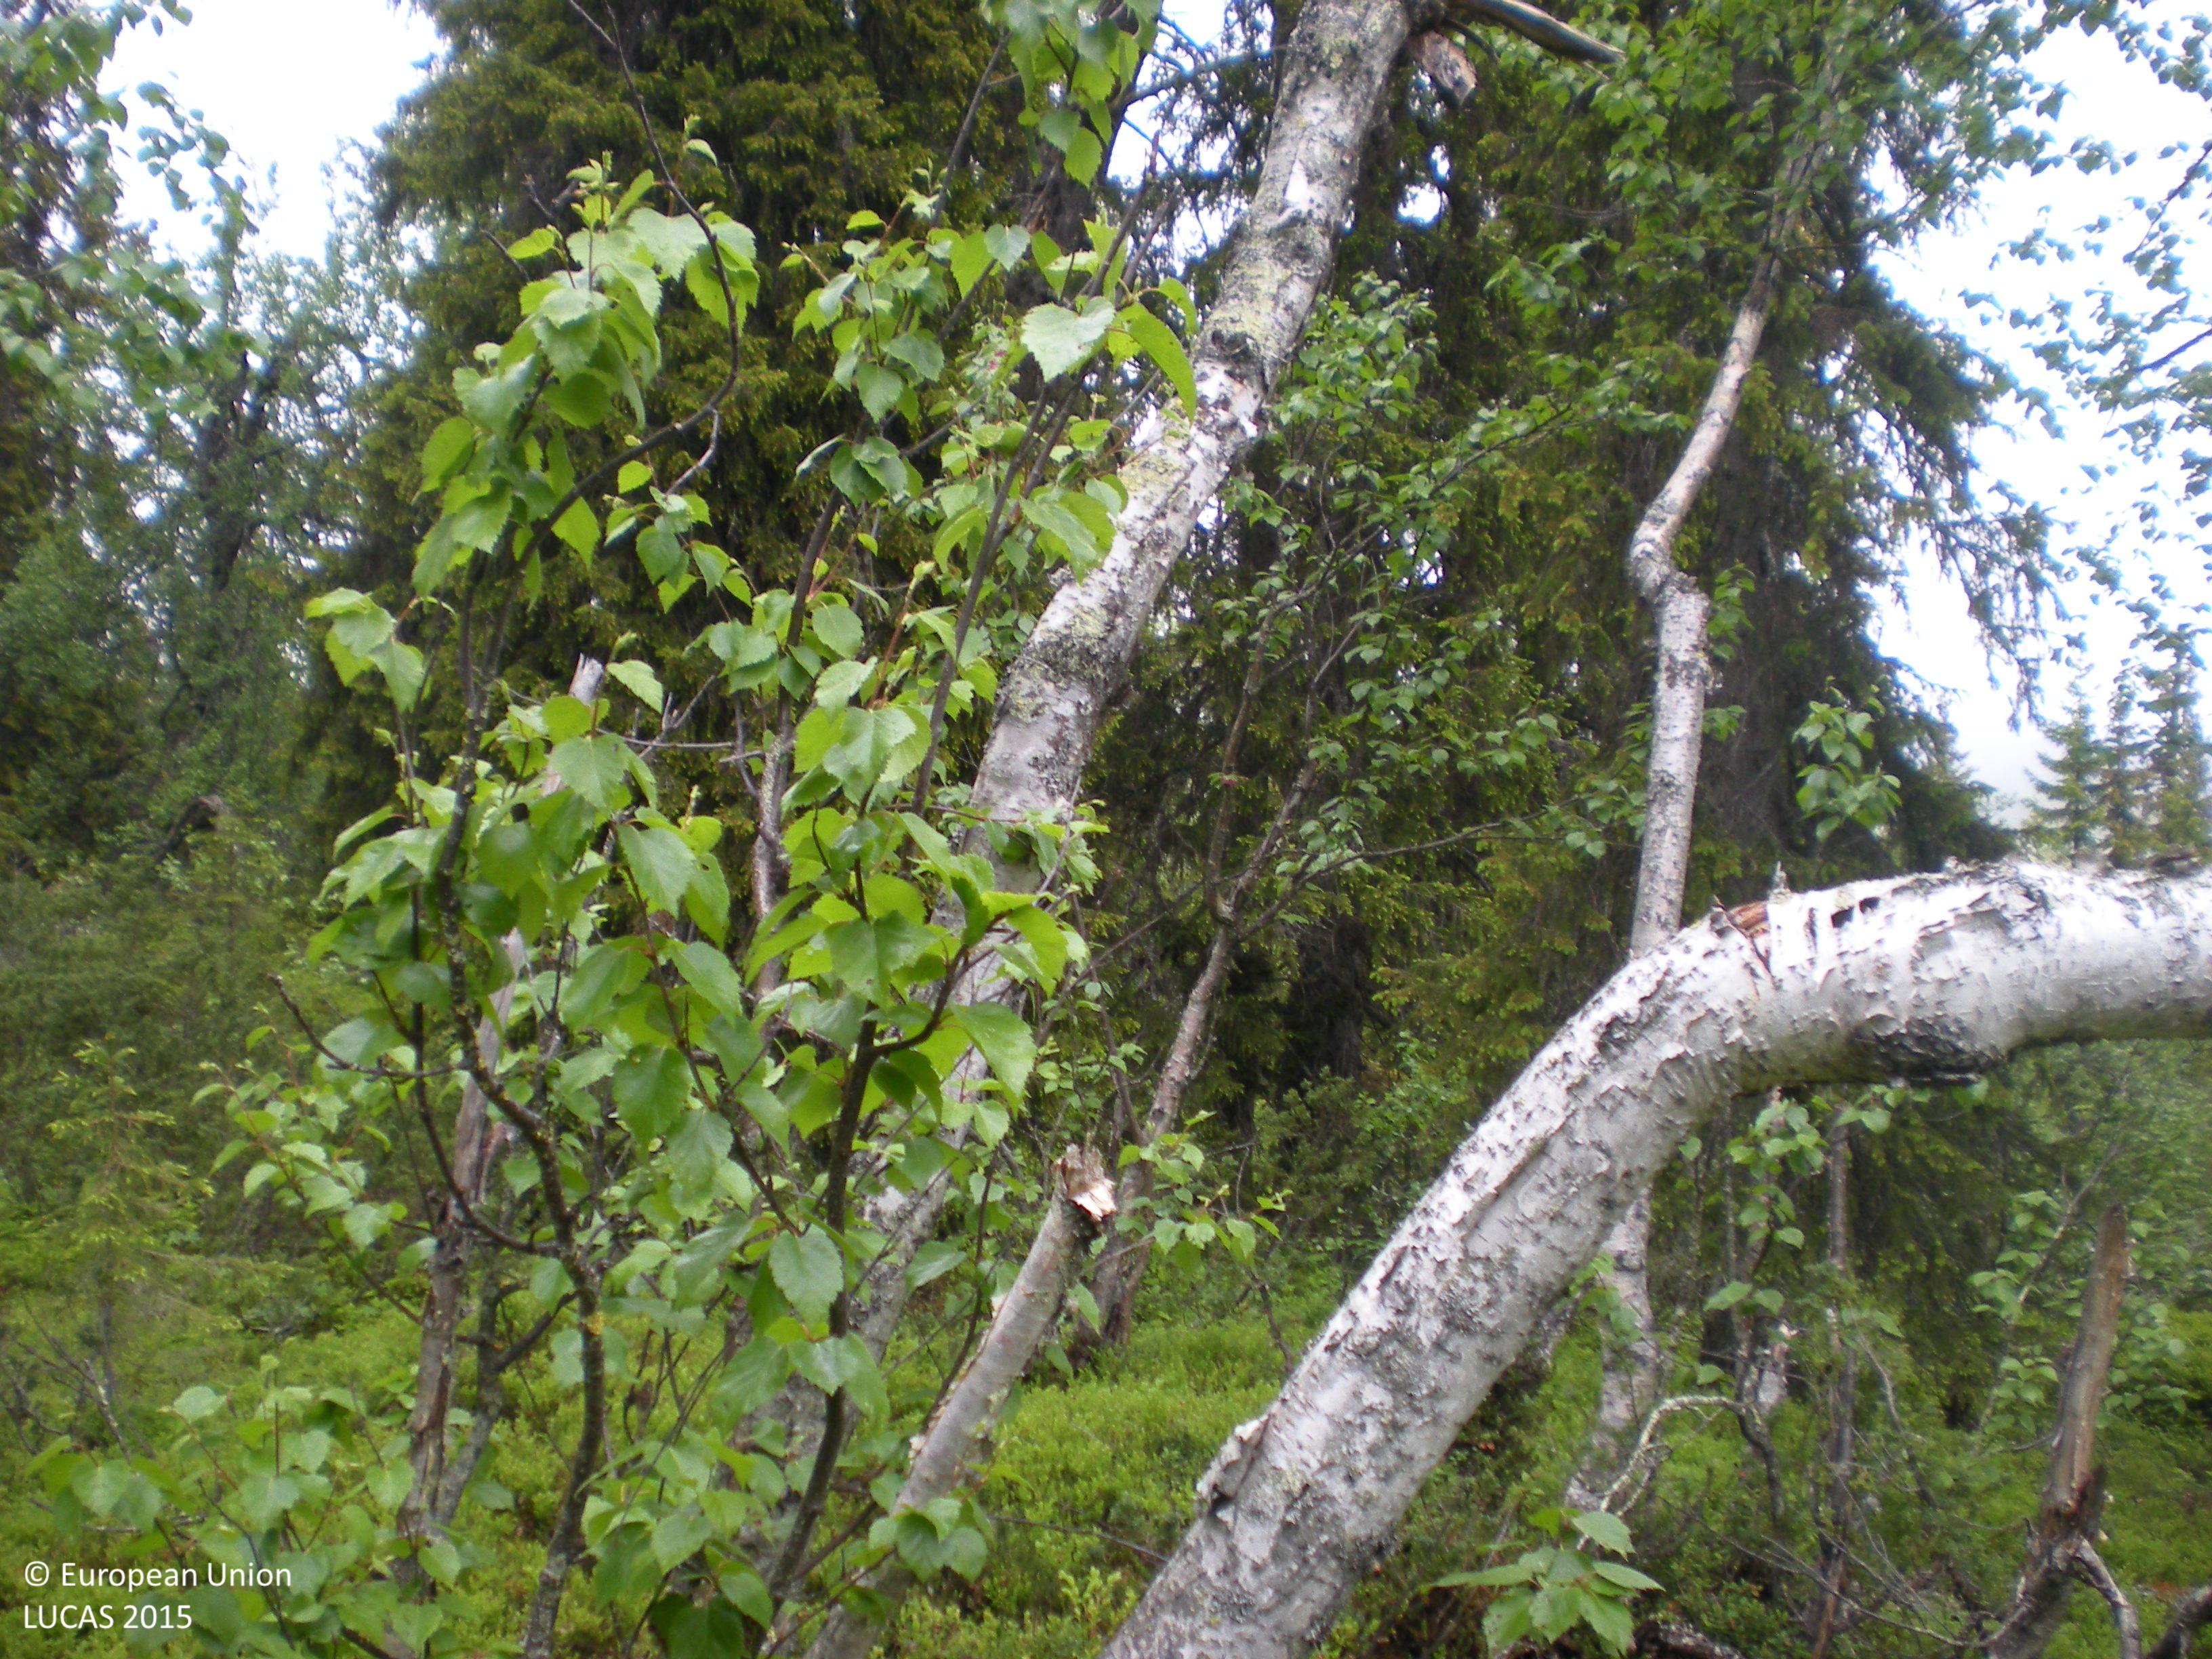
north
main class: Woodland
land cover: Spruce dominated mixed woodland
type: boreal forest
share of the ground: 50 - 75 %
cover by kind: coniferous forest trees 55 %, broadleaved forest trees 20 %, shrubs 20 %, lichens and mosses 5 %
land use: Semi-natural and natural areas not in use
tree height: > 5 m
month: July
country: SE
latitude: 66.1214
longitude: 17.2390
